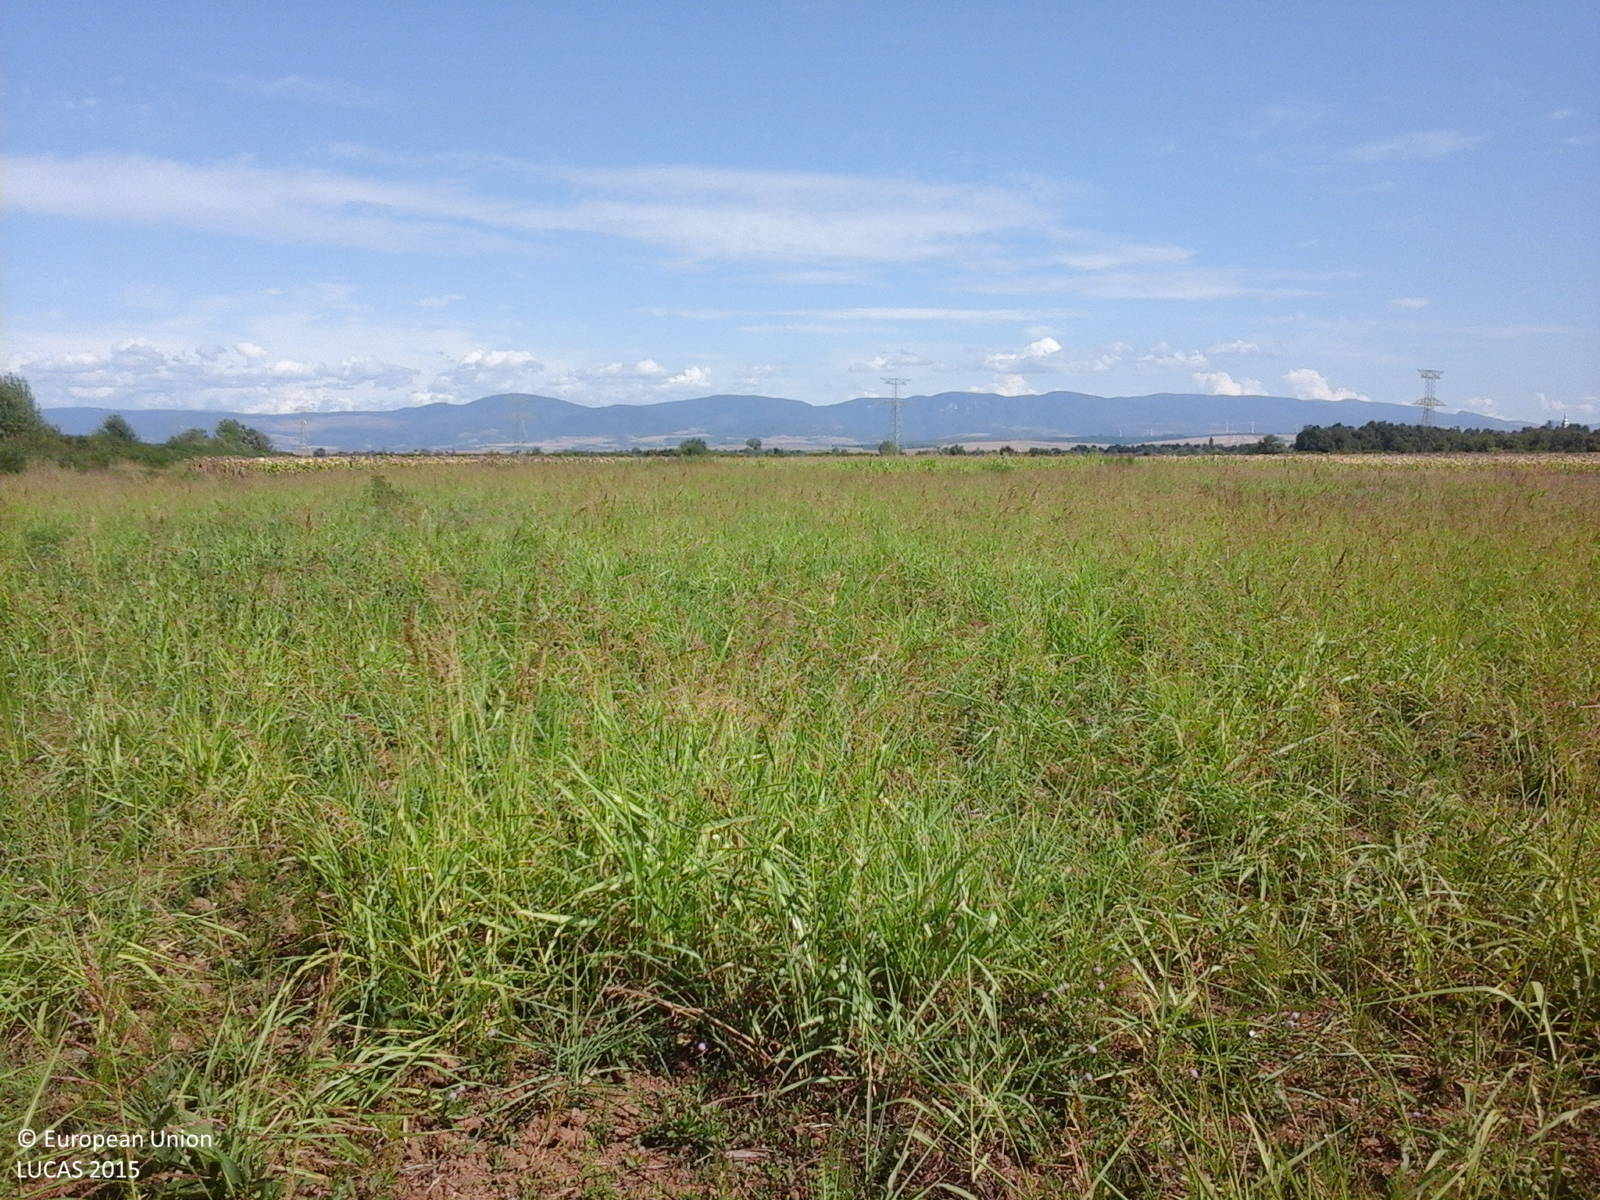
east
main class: Grassland
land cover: Spontaneously vegetated surfaces
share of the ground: > 75 %
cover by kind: herbaceous plants 100 %
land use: Fallow land
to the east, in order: Spontaneously vegetated surfaces; Tracks; Grass margins; Sunflower
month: August
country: RO
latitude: 45.0711
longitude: 21.5249
